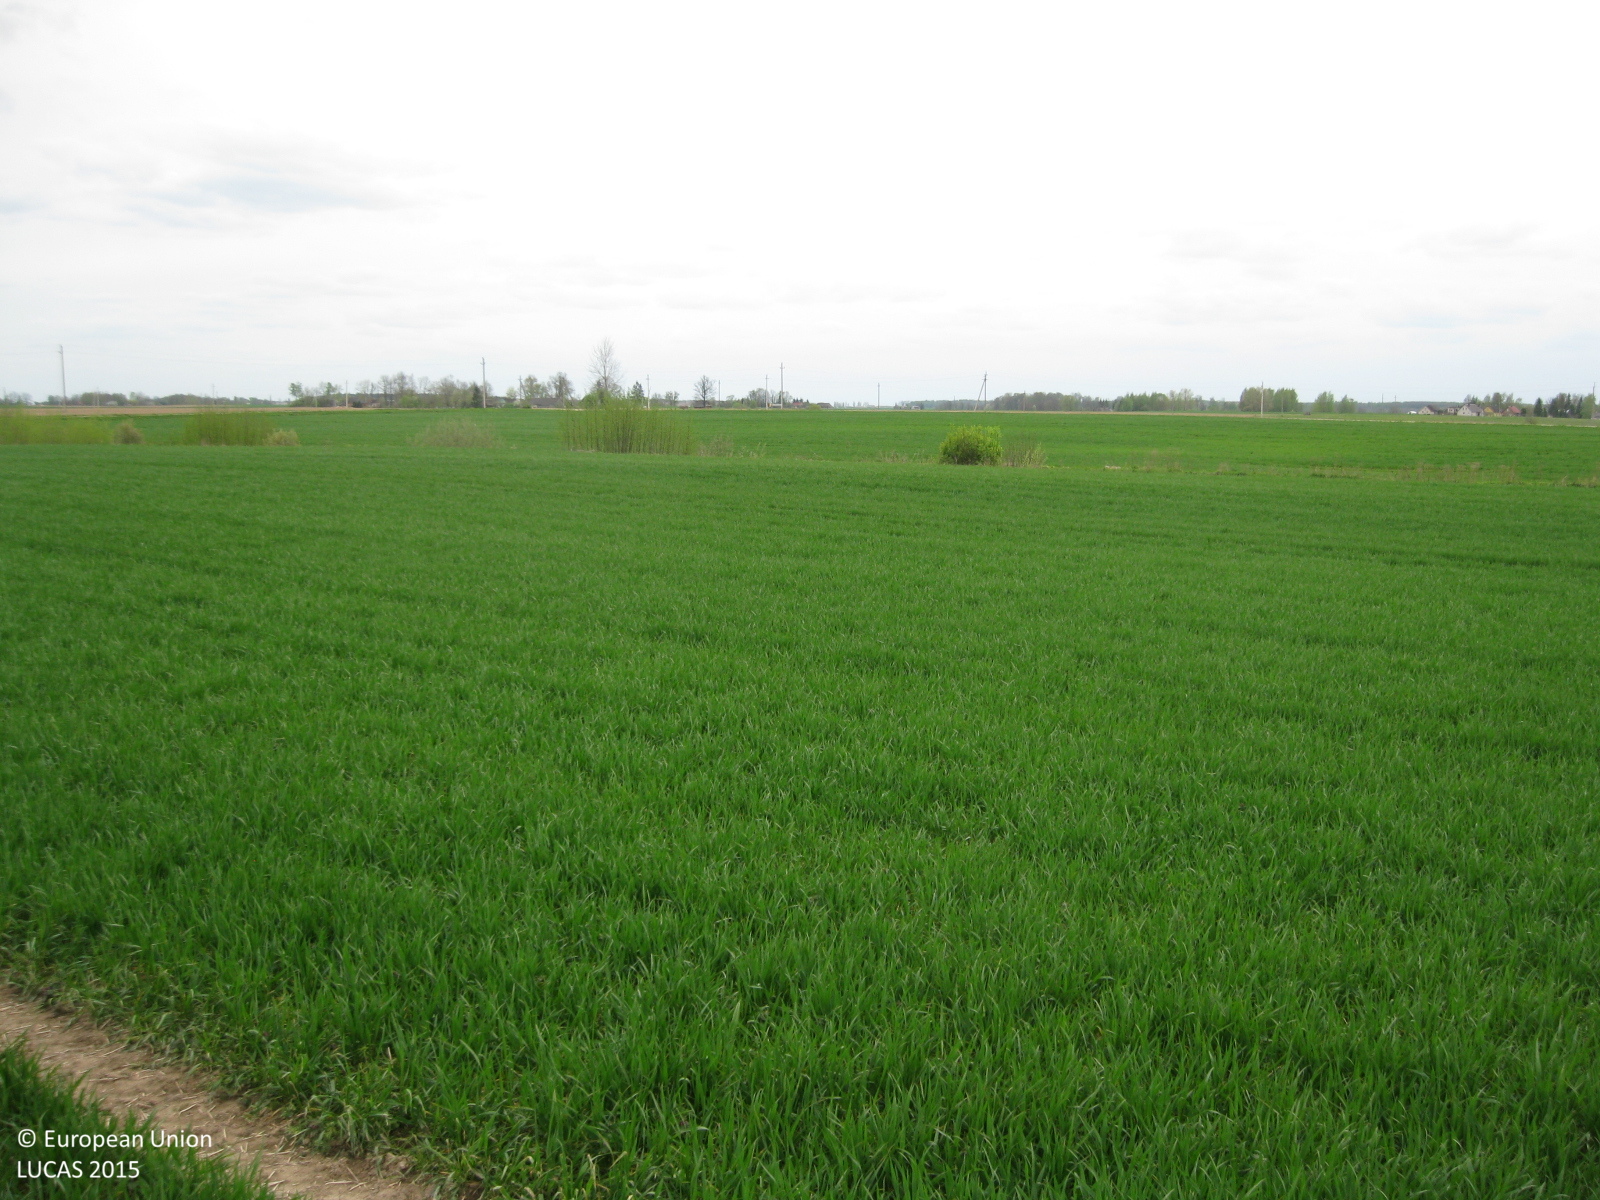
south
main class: Cropland
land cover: Common wheat
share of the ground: > 75 %
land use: Agriculture (excluding fallow land and kitchen gardens)
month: May
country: LT
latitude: 56.1870
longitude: 24.4527
